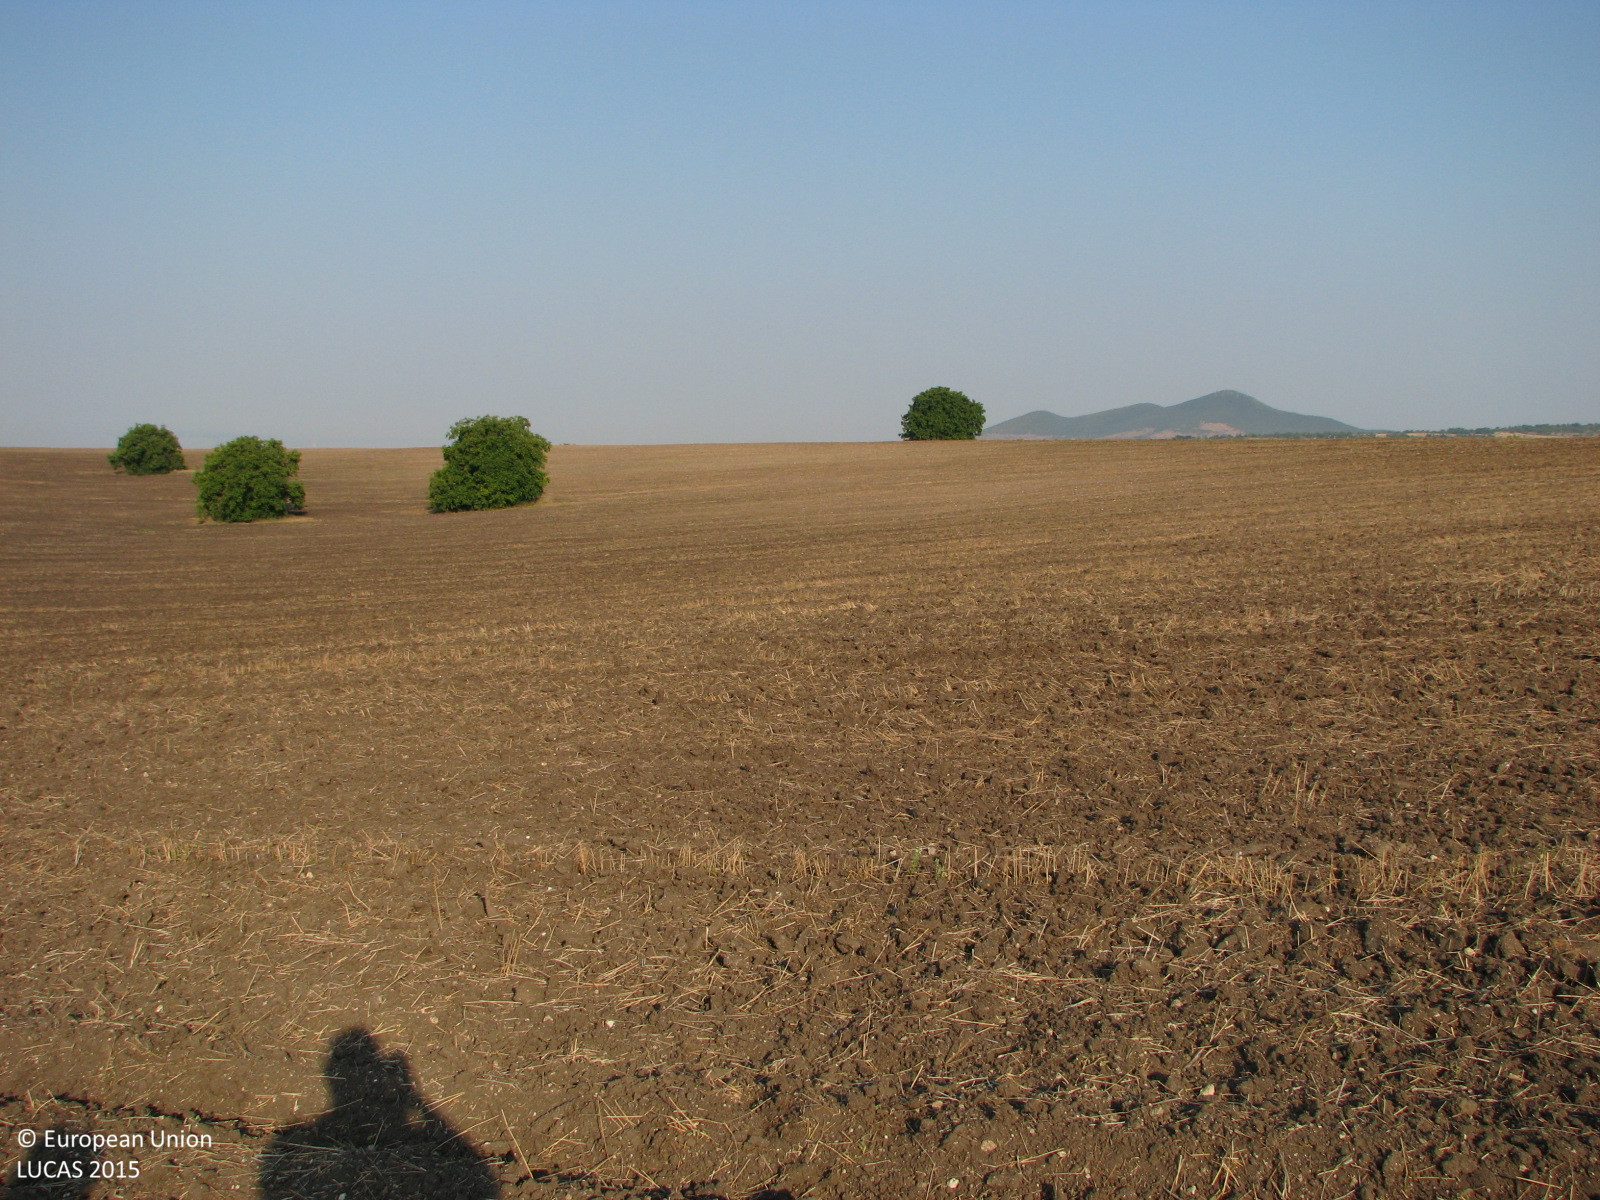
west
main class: Cropland
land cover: Other non-permanent industrial crops
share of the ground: < 10 %
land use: Agriculture (excluding fallow land and kitchen gardens)
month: August
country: BG
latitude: 42.1821
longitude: 26.4439
